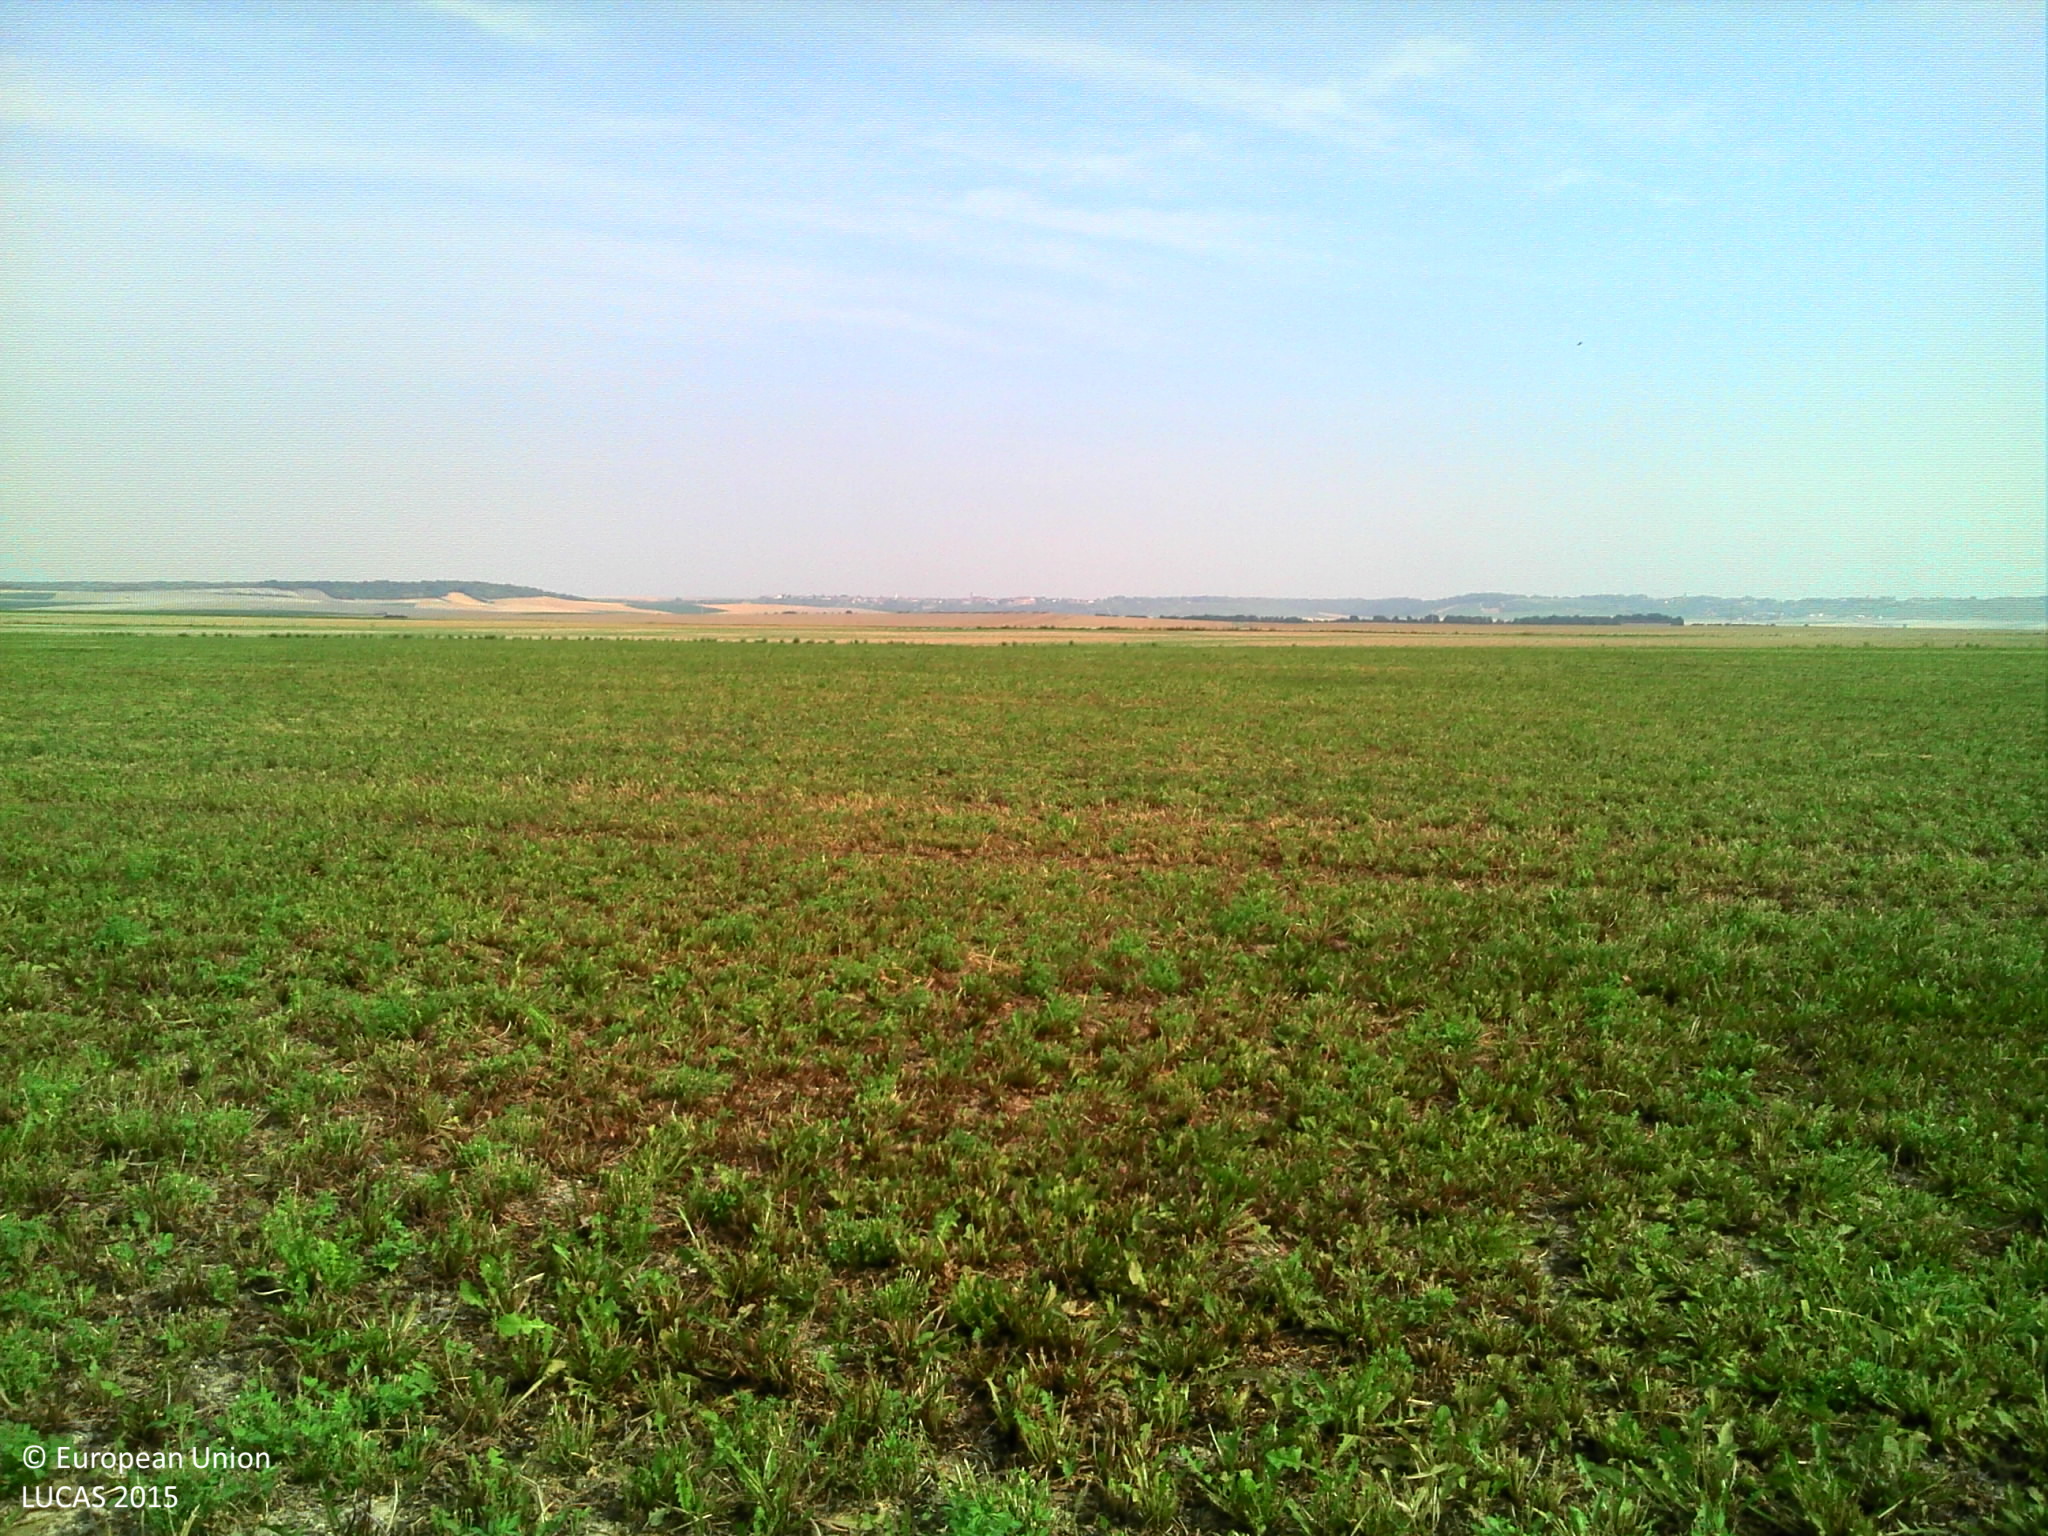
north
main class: Cropland
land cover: Temporary grasslands
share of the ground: > 75 %
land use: Agriculture (excluding fallow land and kitchen gardens)
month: August
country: FR
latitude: 48.6979
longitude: 3.7856
